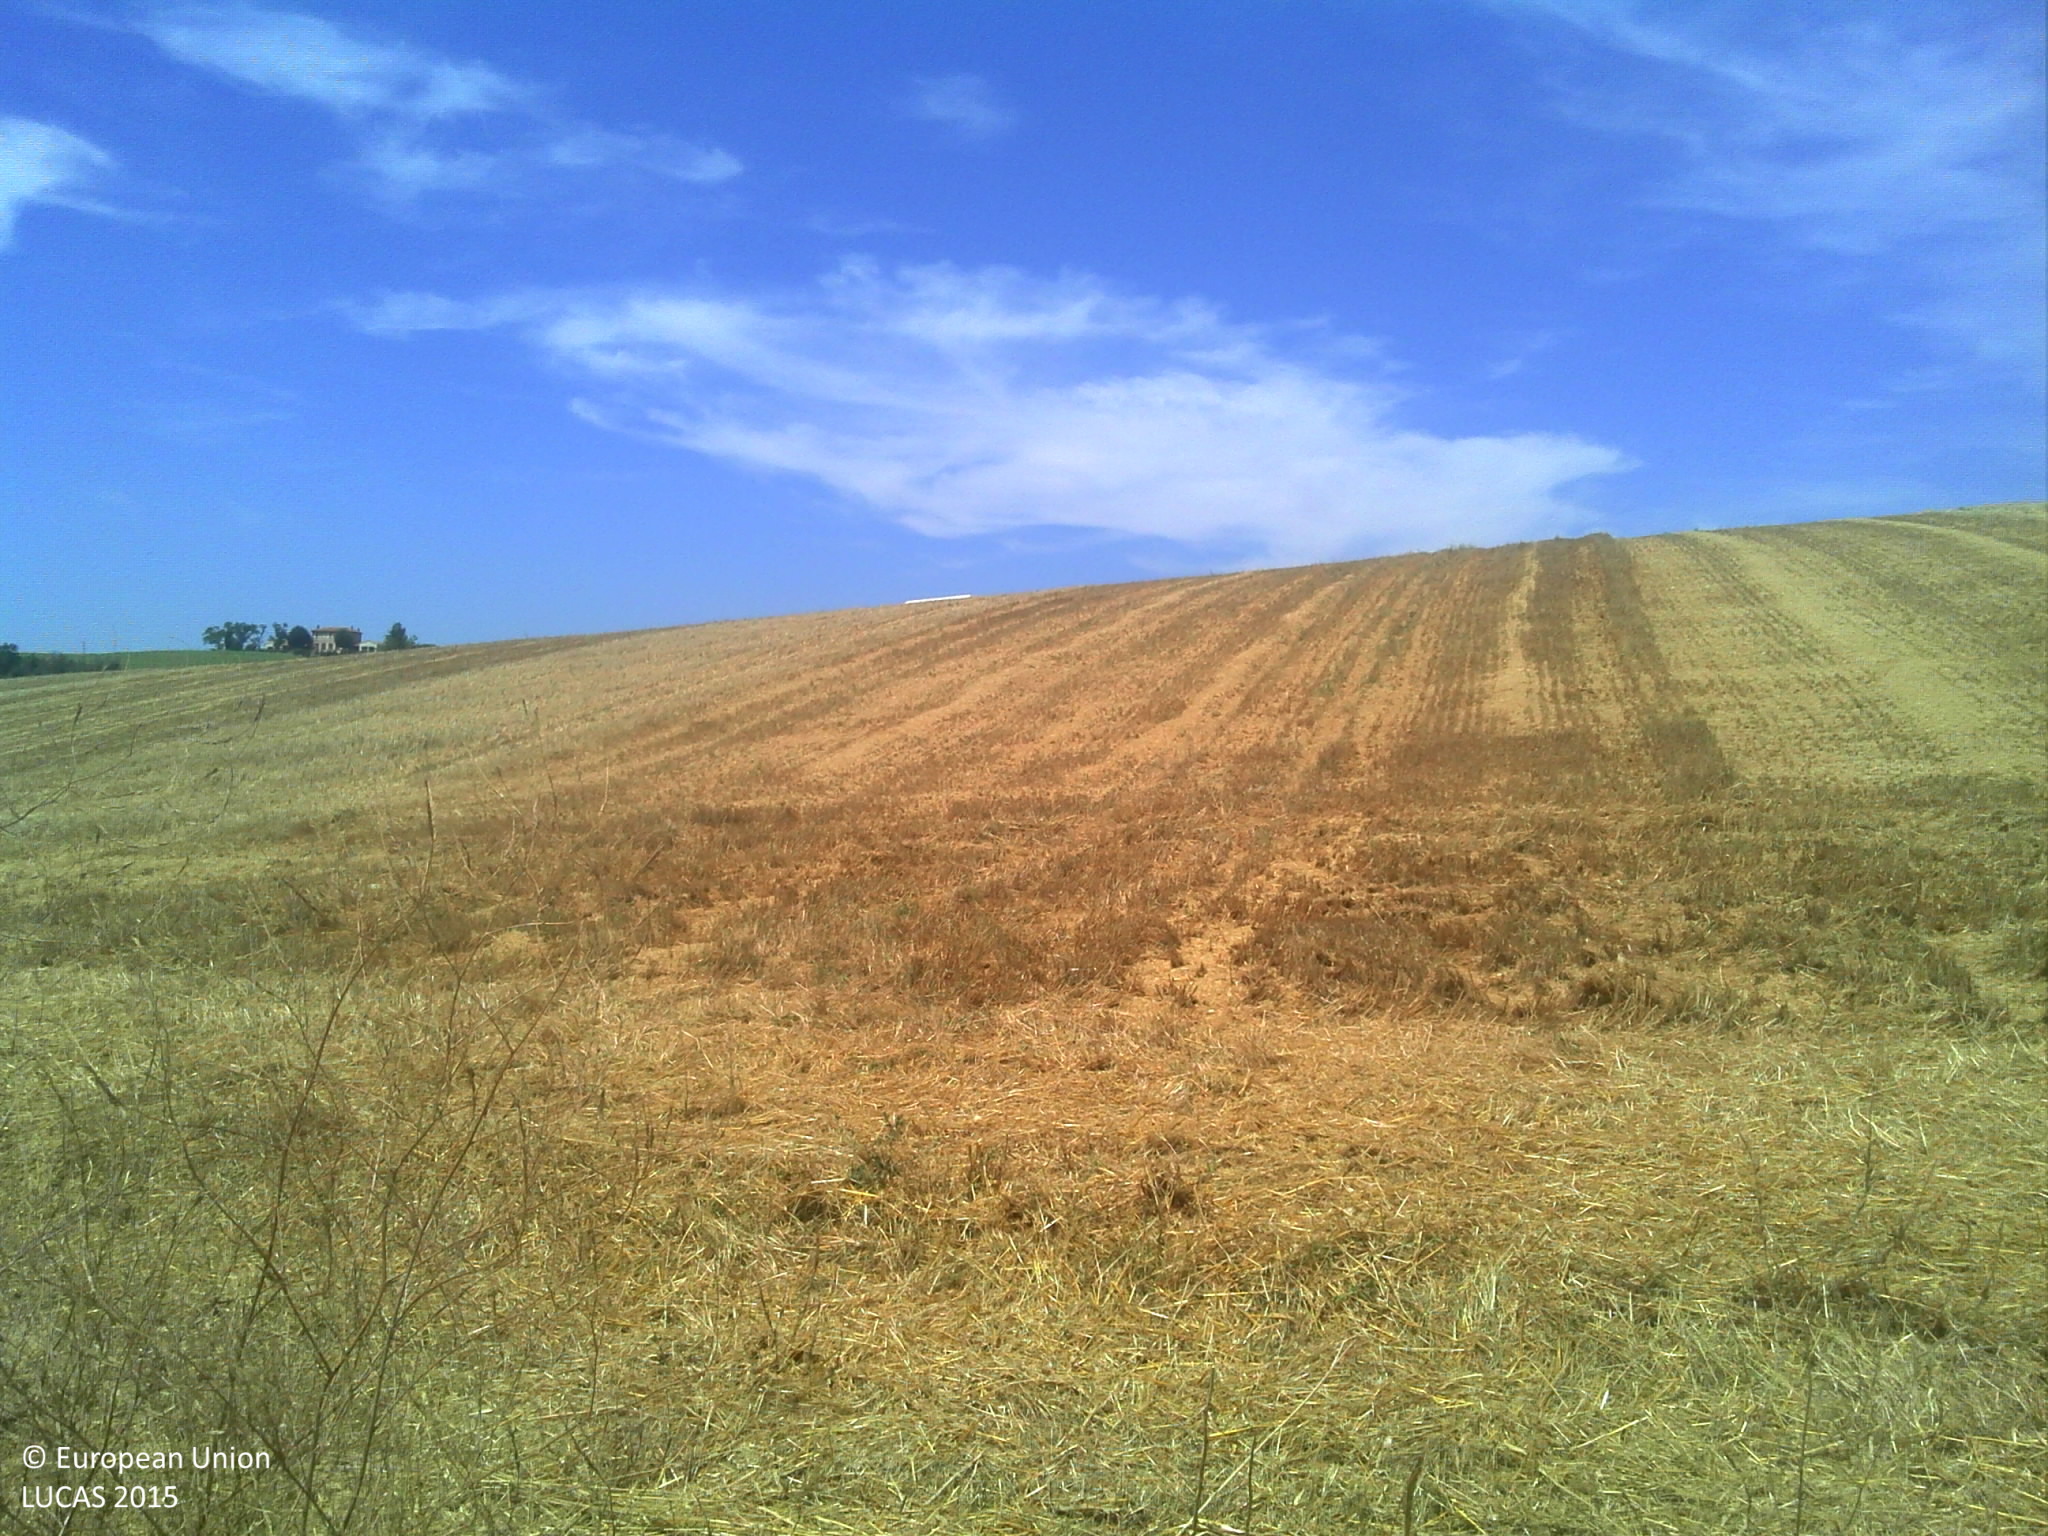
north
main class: Cropland
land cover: Common wheat
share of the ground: > 75 %
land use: Agriculture (excluding fallow land and kitchen gardens)
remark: Harvested field
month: July
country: FR
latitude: 43.4523
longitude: 1.4395
